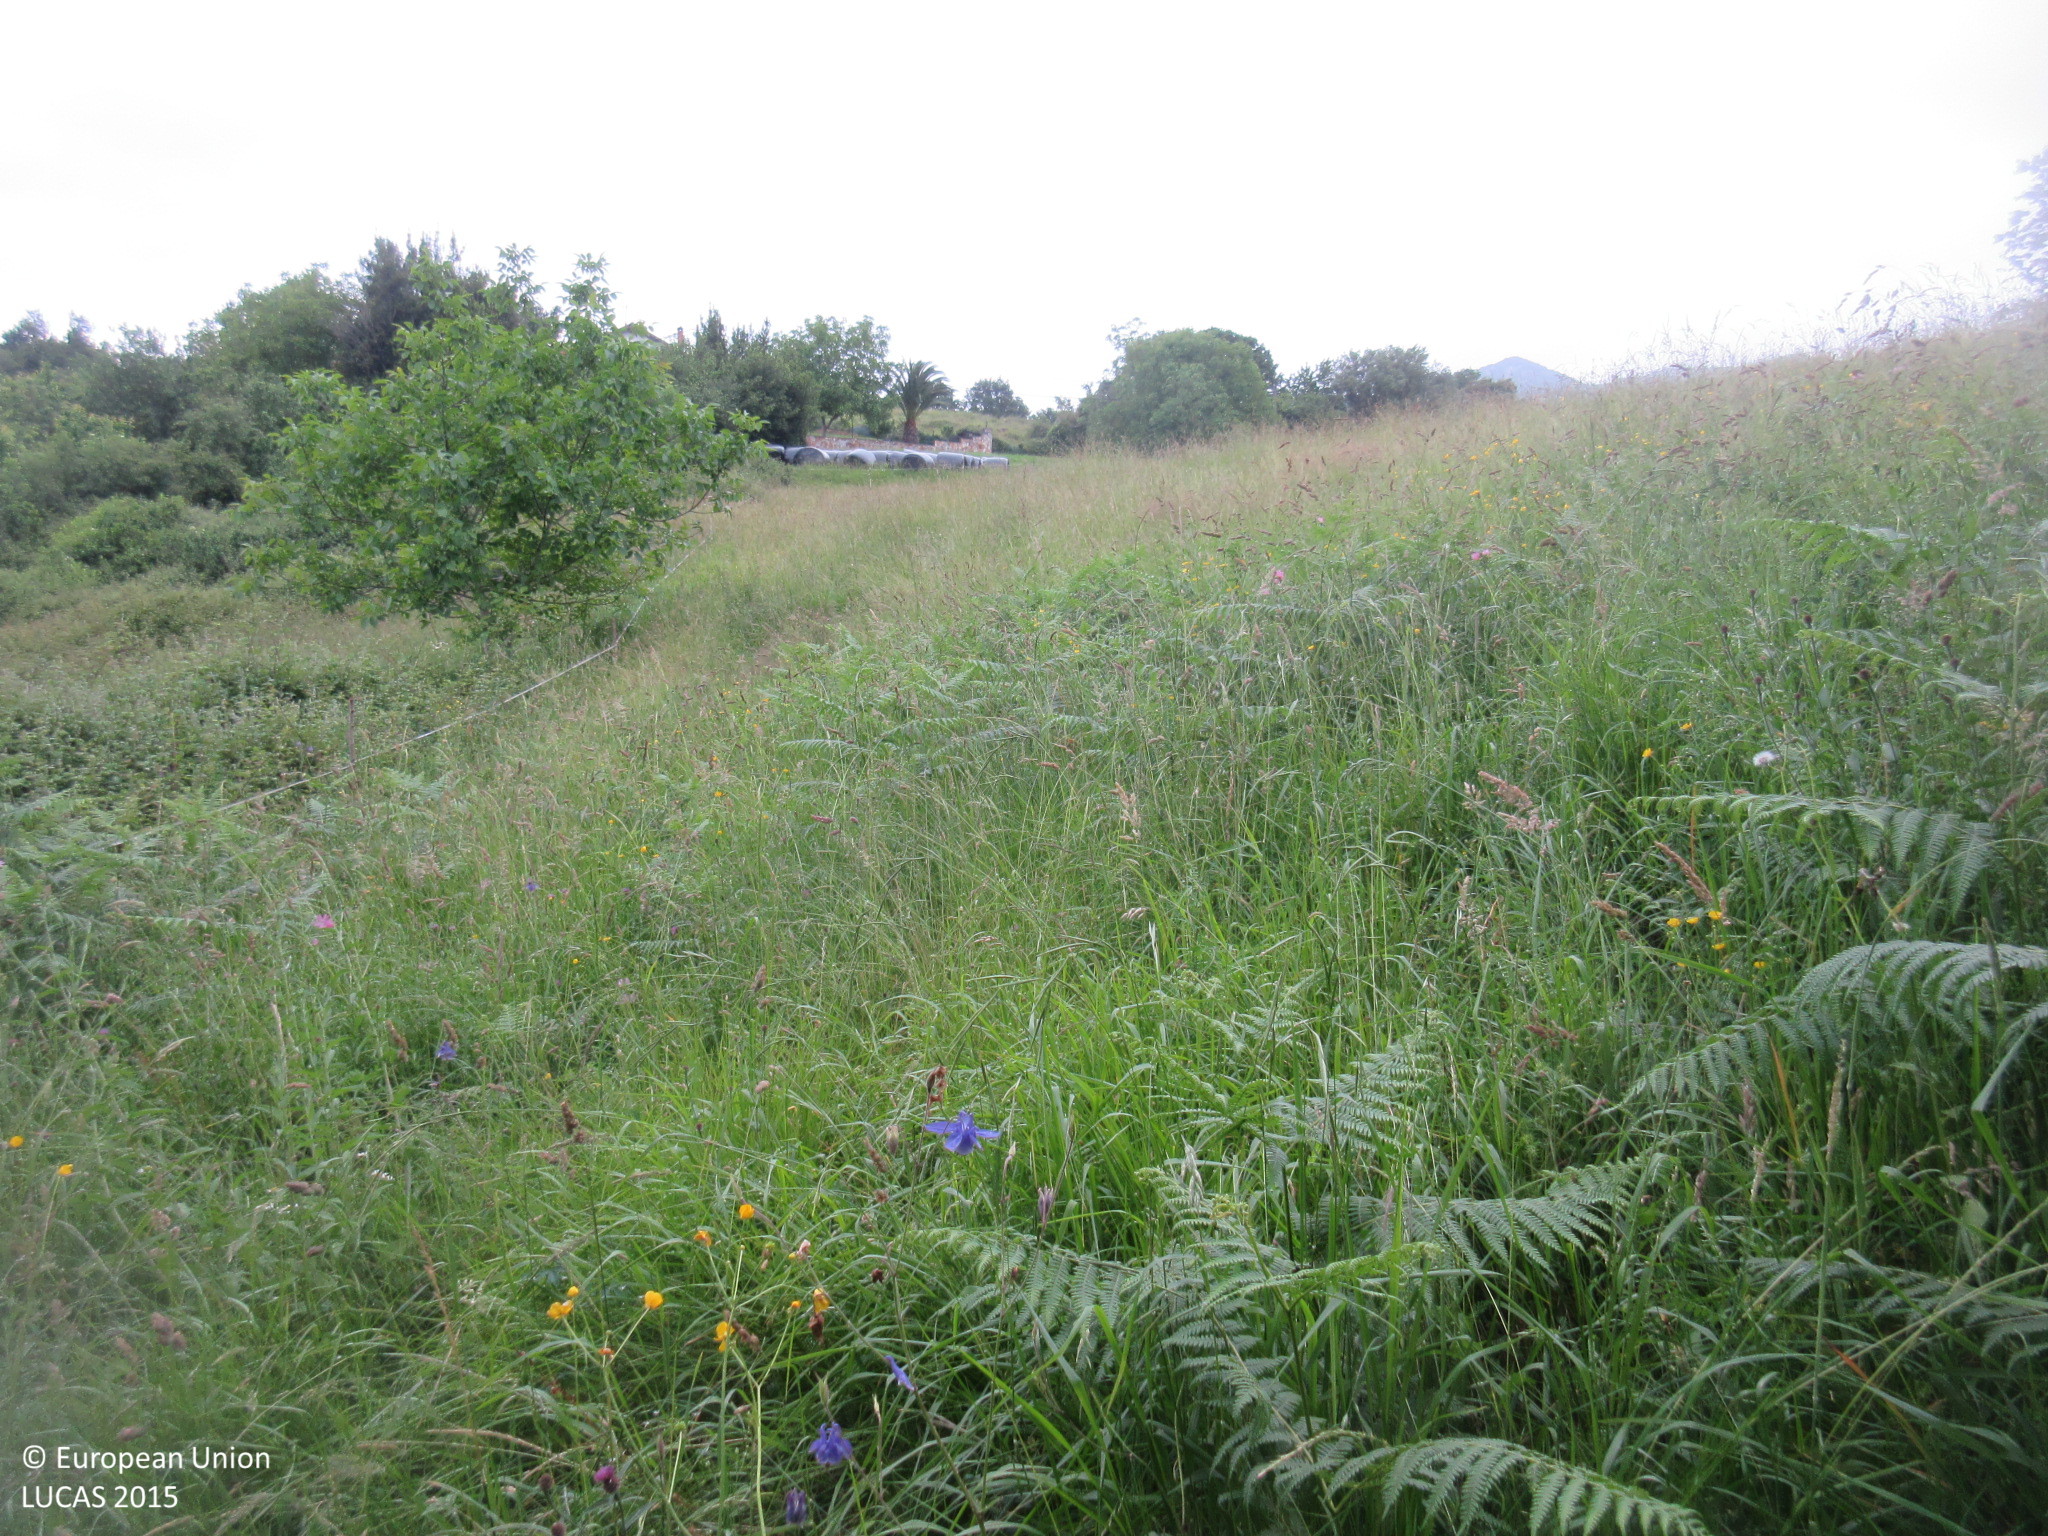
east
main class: Woodland
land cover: Broadleaved woodland
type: thermophilous deciduous forest
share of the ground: > 75 %
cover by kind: broadleaved forest trees 90 %, shrubs 10 %
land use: Semi-natural and natural areas not in use
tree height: > 5 m
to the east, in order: Broadleaved woodland; Grassland without tree/shrub cover; Rock outcrops; Grassland without tree/shrub cover; Broadleaved woodland; Grassland without tree/shrub cover; Tracks; Electric lines; Managed hedges; Grassland without tree/shrub cover; Shruby margins; Apple fruit
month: June
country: ES
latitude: 43.3101
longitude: -3.4185
